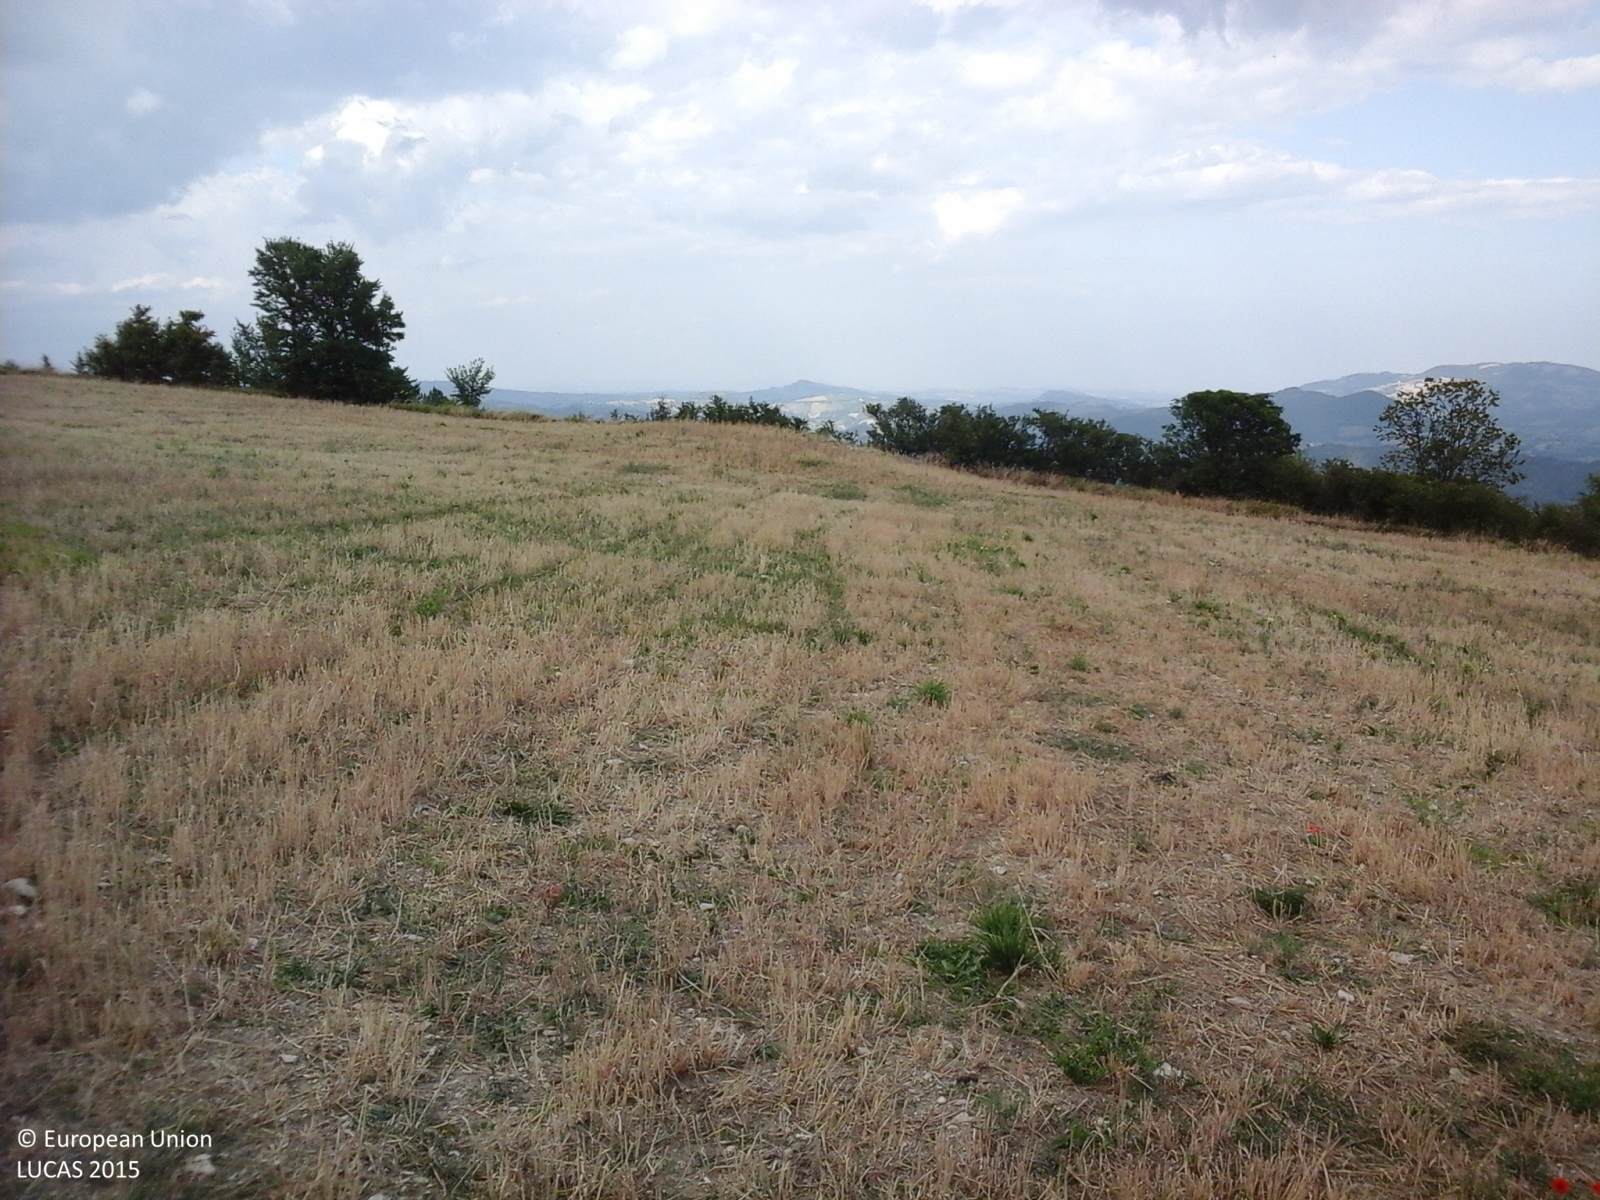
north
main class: Cropland
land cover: Durum wheat
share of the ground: > 75 %
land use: Agriculture (excluding fallow land and kitchen gardens)
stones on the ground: < 10 %
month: August
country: IT
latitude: 42.9252
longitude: 13.3108
